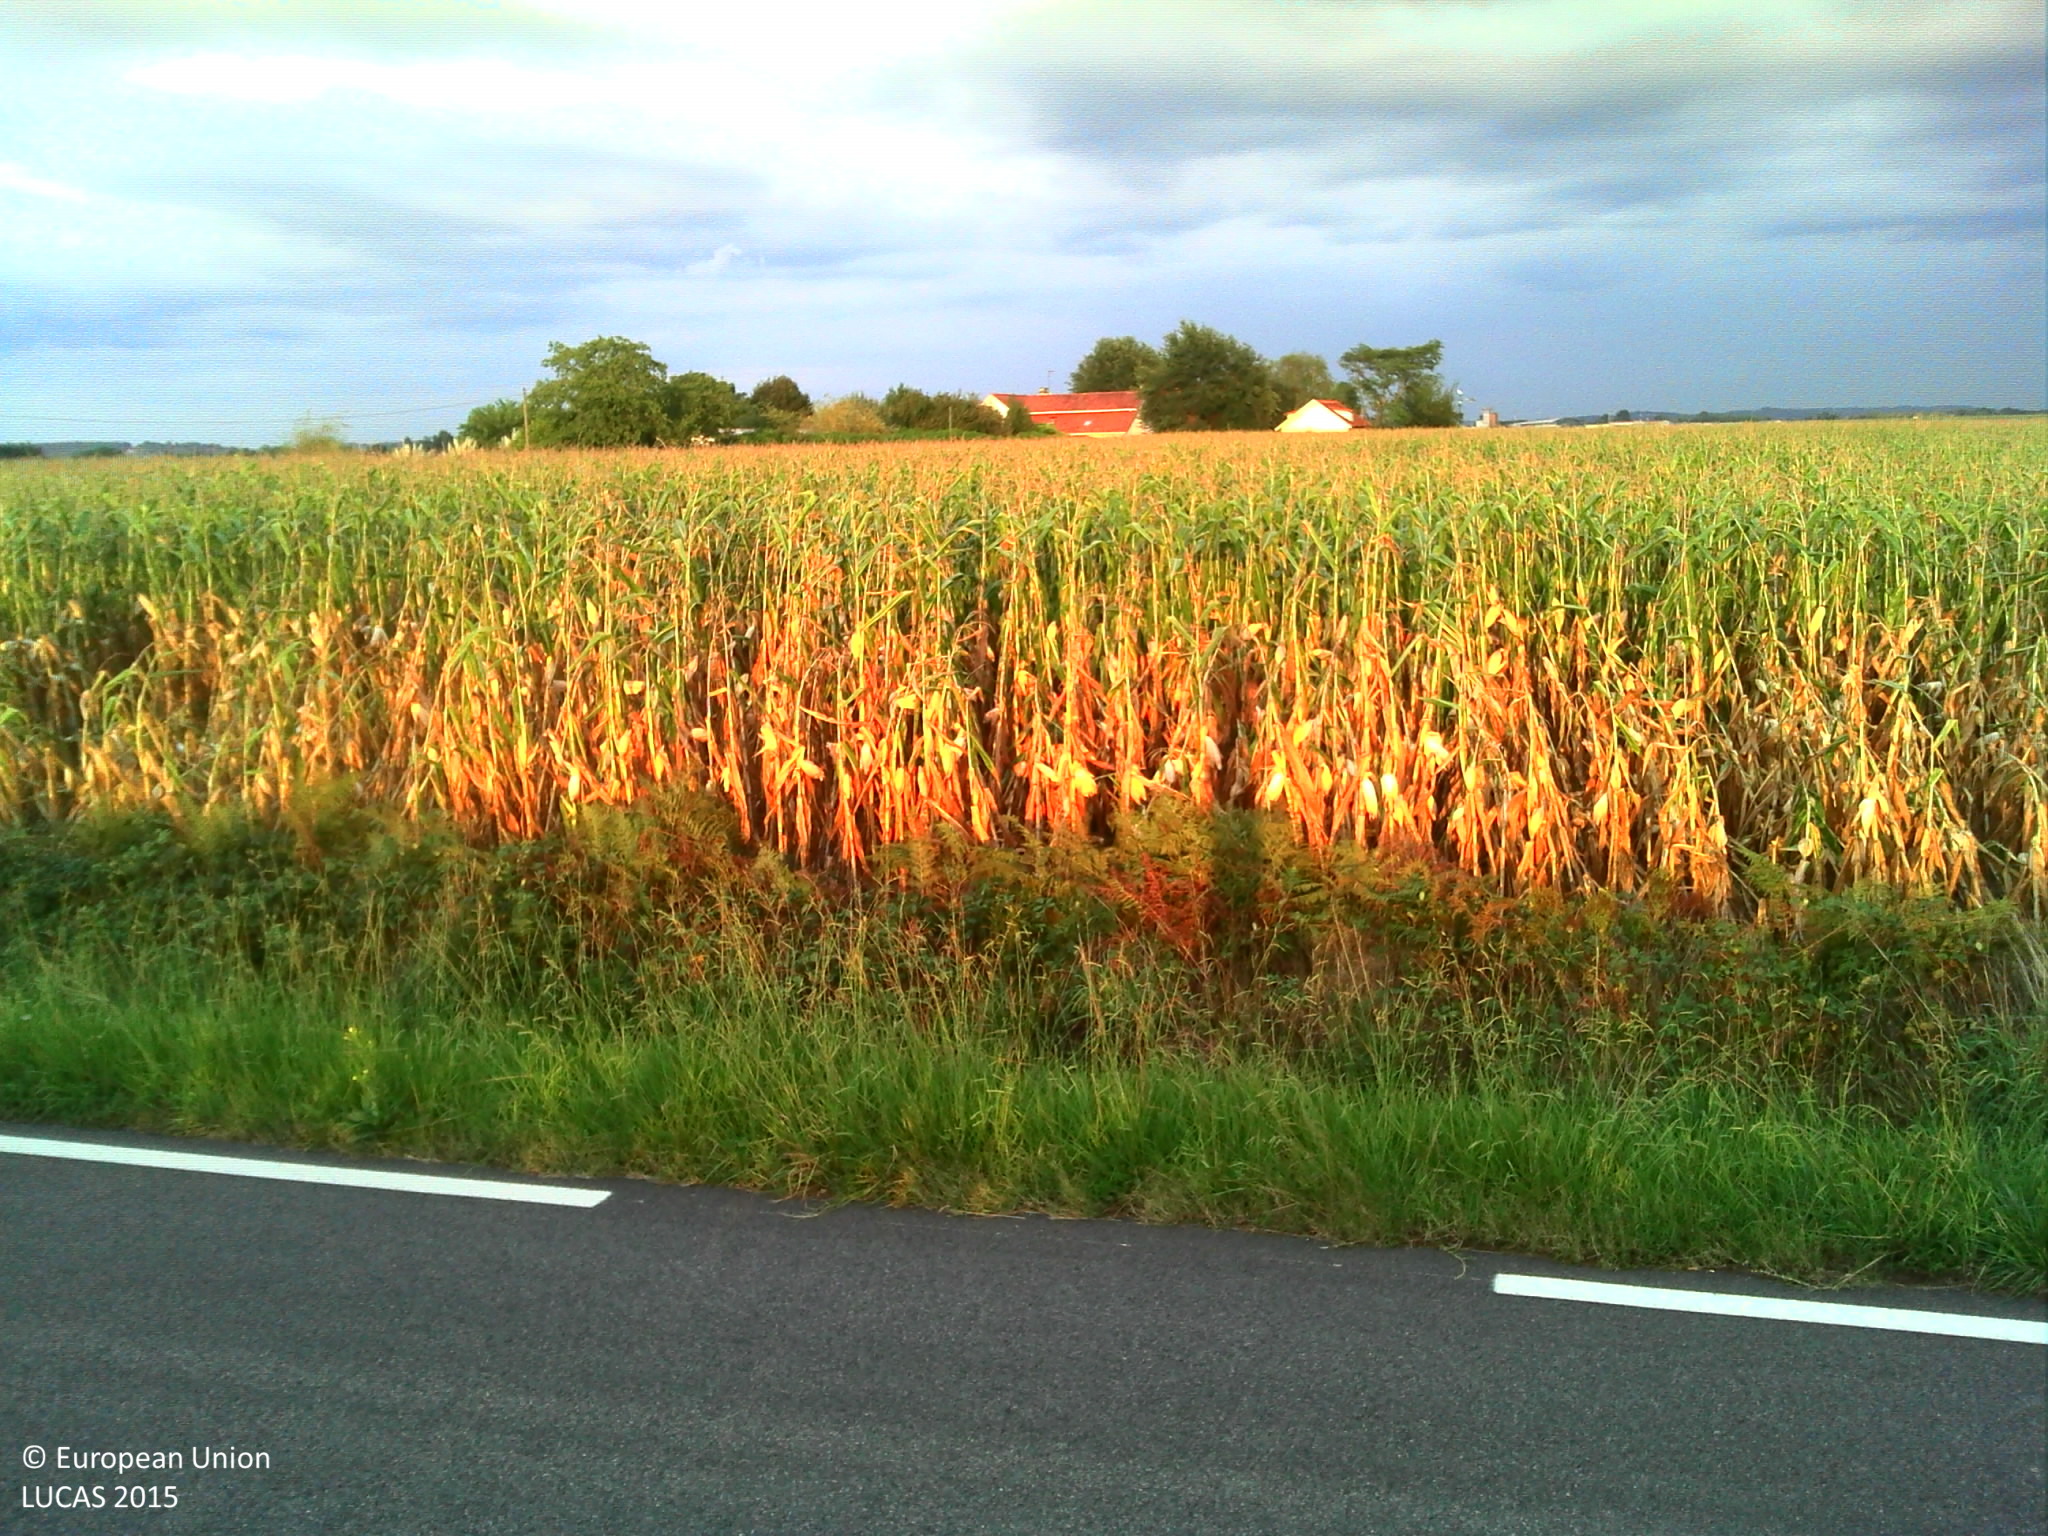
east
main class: Cropland
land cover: Maize
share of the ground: > 75 %
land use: Agriculture (excluding fallow land and kitchen gardens)
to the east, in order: Maize; Electric lines; Ditches and canals; Grass margins; Paved roads, cycling and walking lanes; Grass margins; Ditches and canals; Maize; Artificial constructions in urban areas
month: September
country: FR
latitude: 43.3864
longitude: -0.4389
